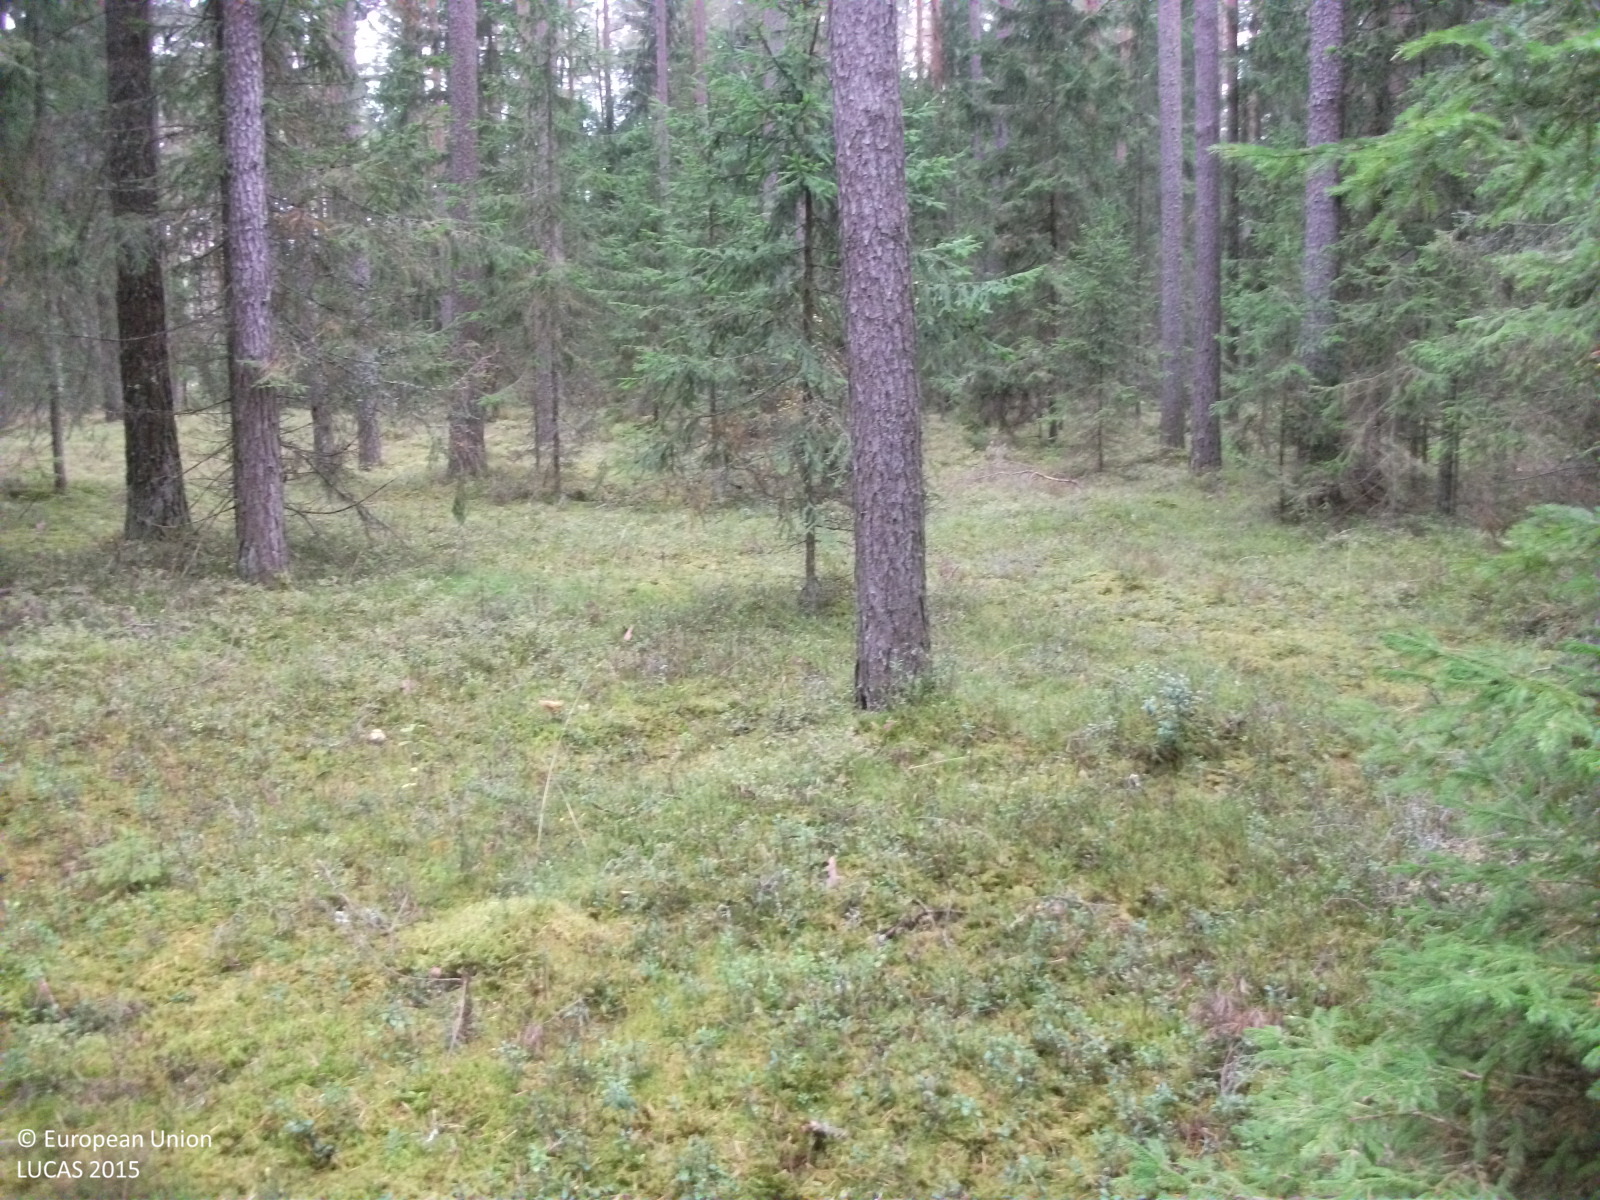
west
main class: Woodland
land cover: Other coniferous woodland
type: hemiboreal forest and nemoral coniferous forest and mixed broadleaved-coniferous forest
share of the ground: > 75 %
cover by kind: coniferous forest trees 80 %, lichens and mosses 15 %, herbaceous plants 5 %
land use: Forestry
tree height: > 5 m
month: September
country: LV
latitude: 57.7263
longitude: 24.4451
